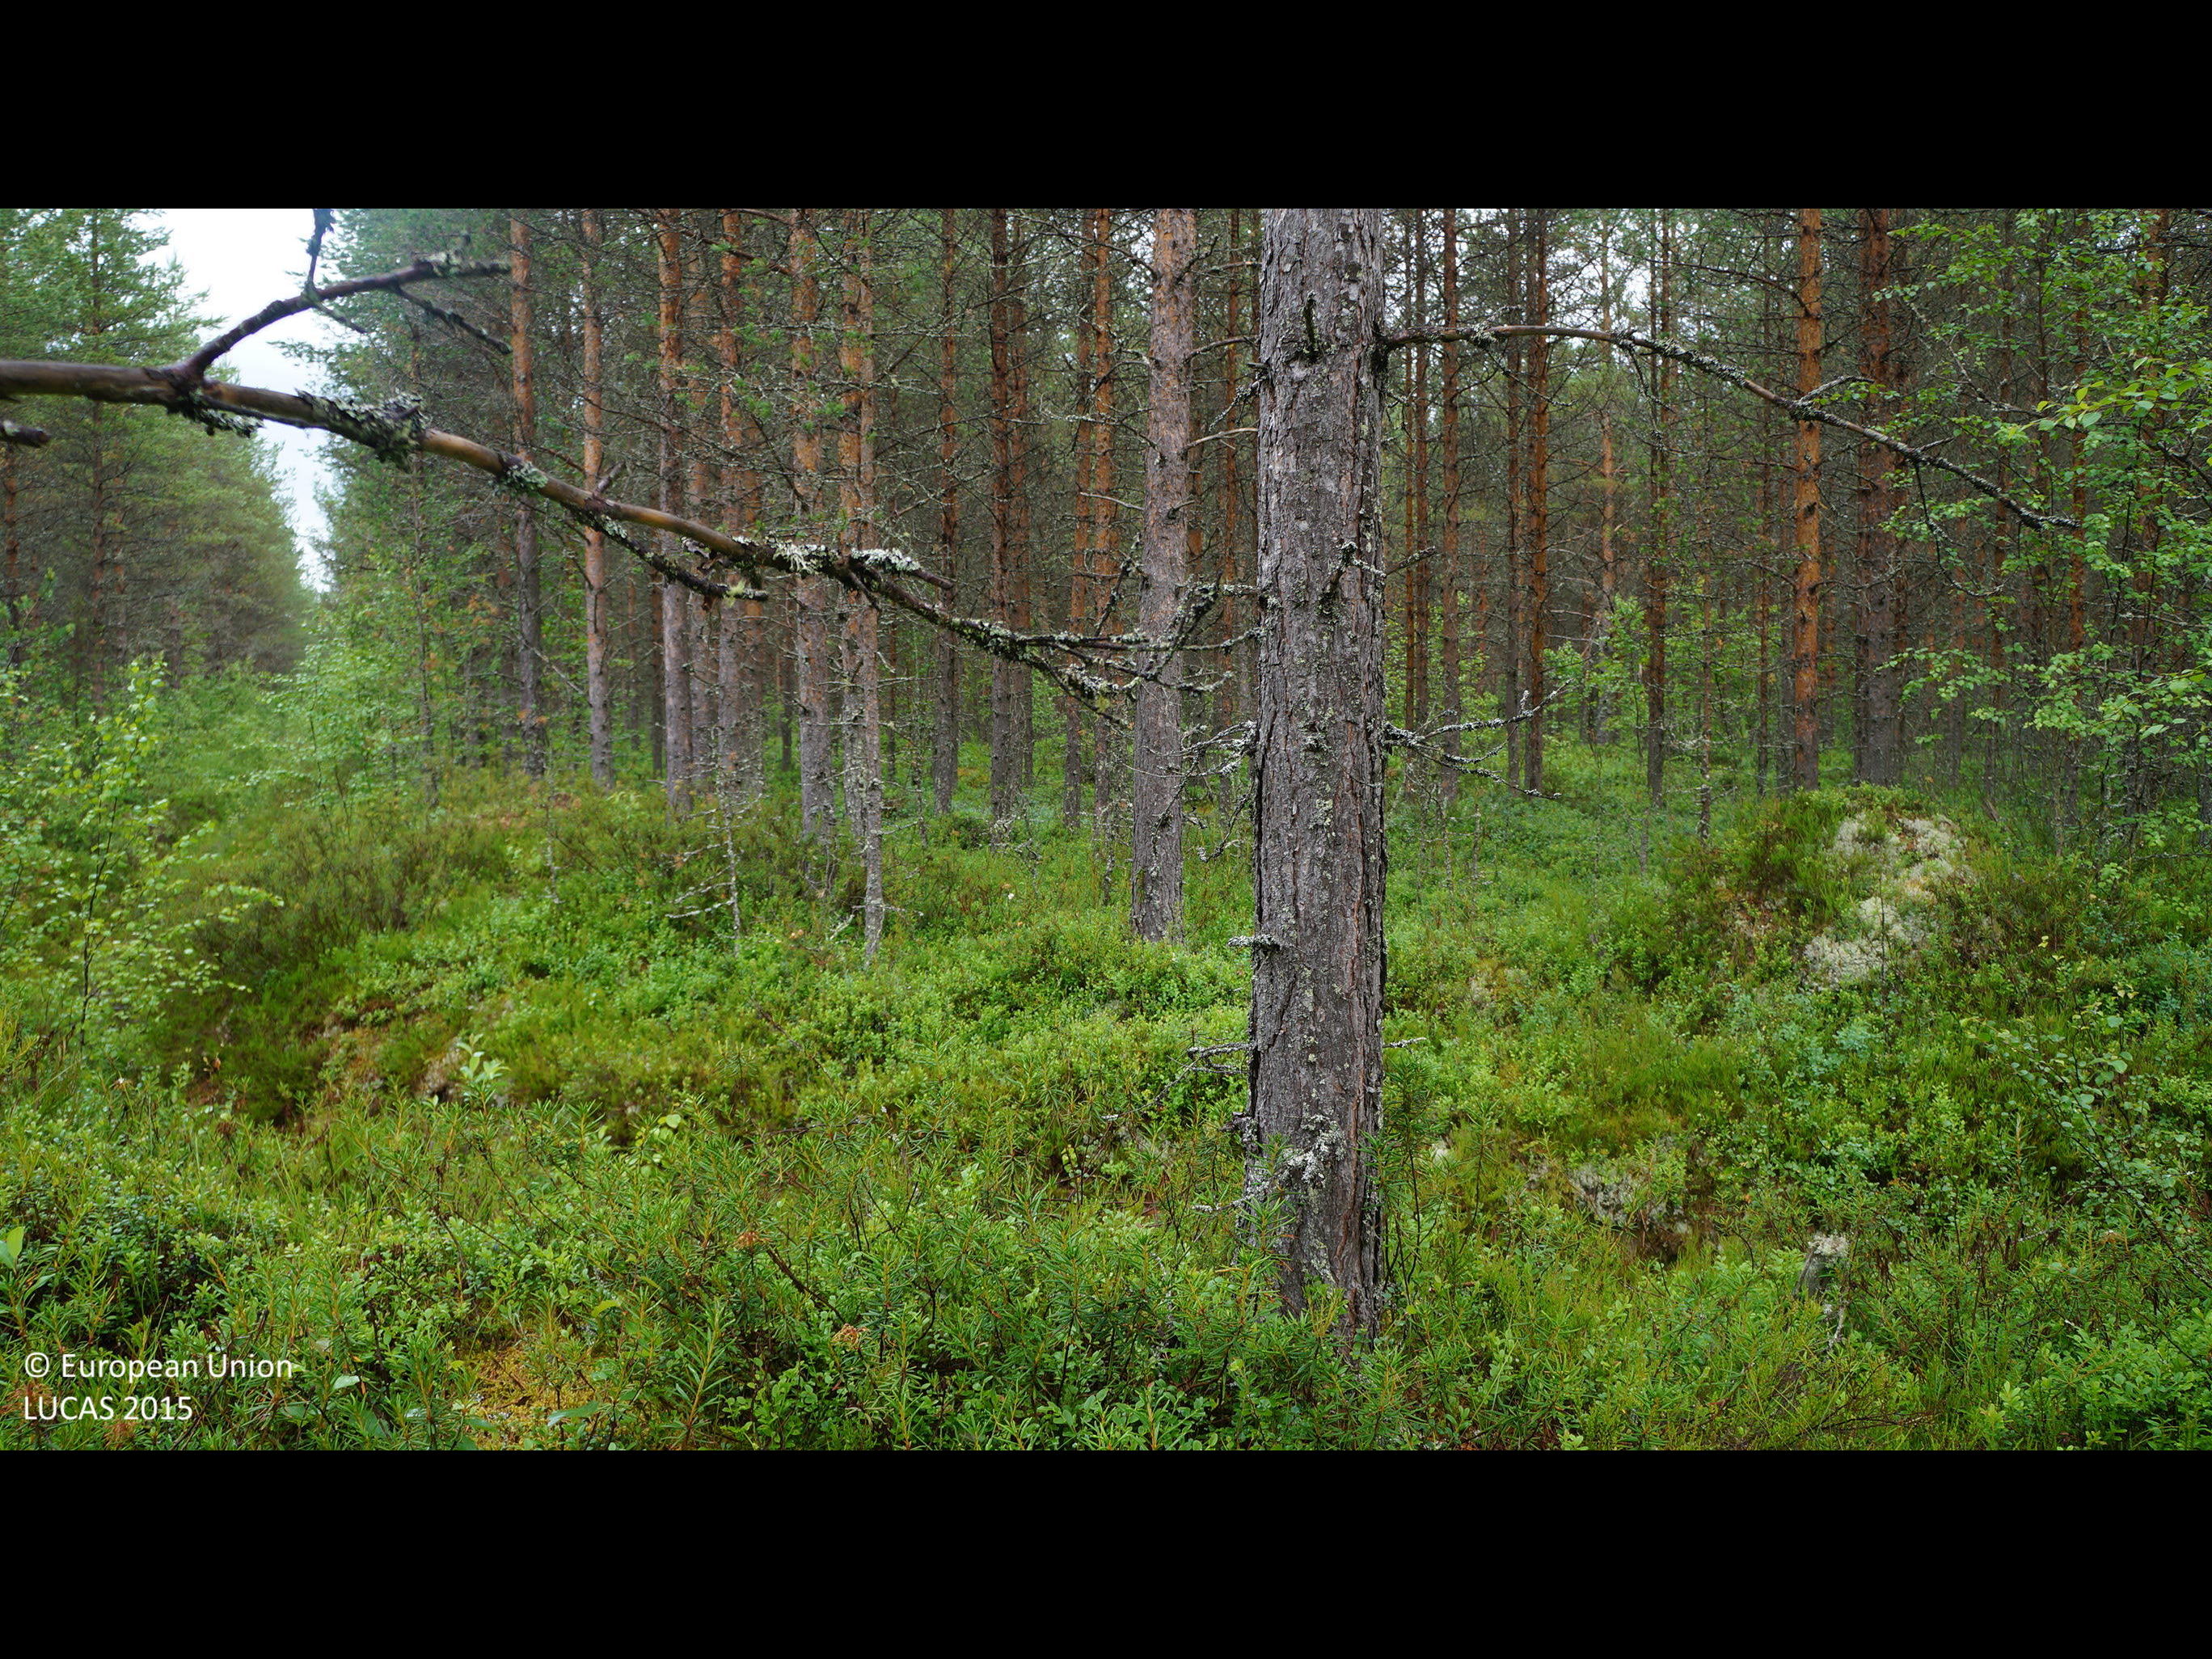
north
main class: Woodland
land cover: Pine dominated coniferous woodland
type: boreal forest
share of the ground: 50 - 75 %
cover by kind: coniferous forest trees 55 %, shrubs 40 %, broadleaved forest trees 5 %
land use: Forestry
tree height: > 5 m
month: July
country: FI
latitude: 64.4767
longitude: 24.5689
